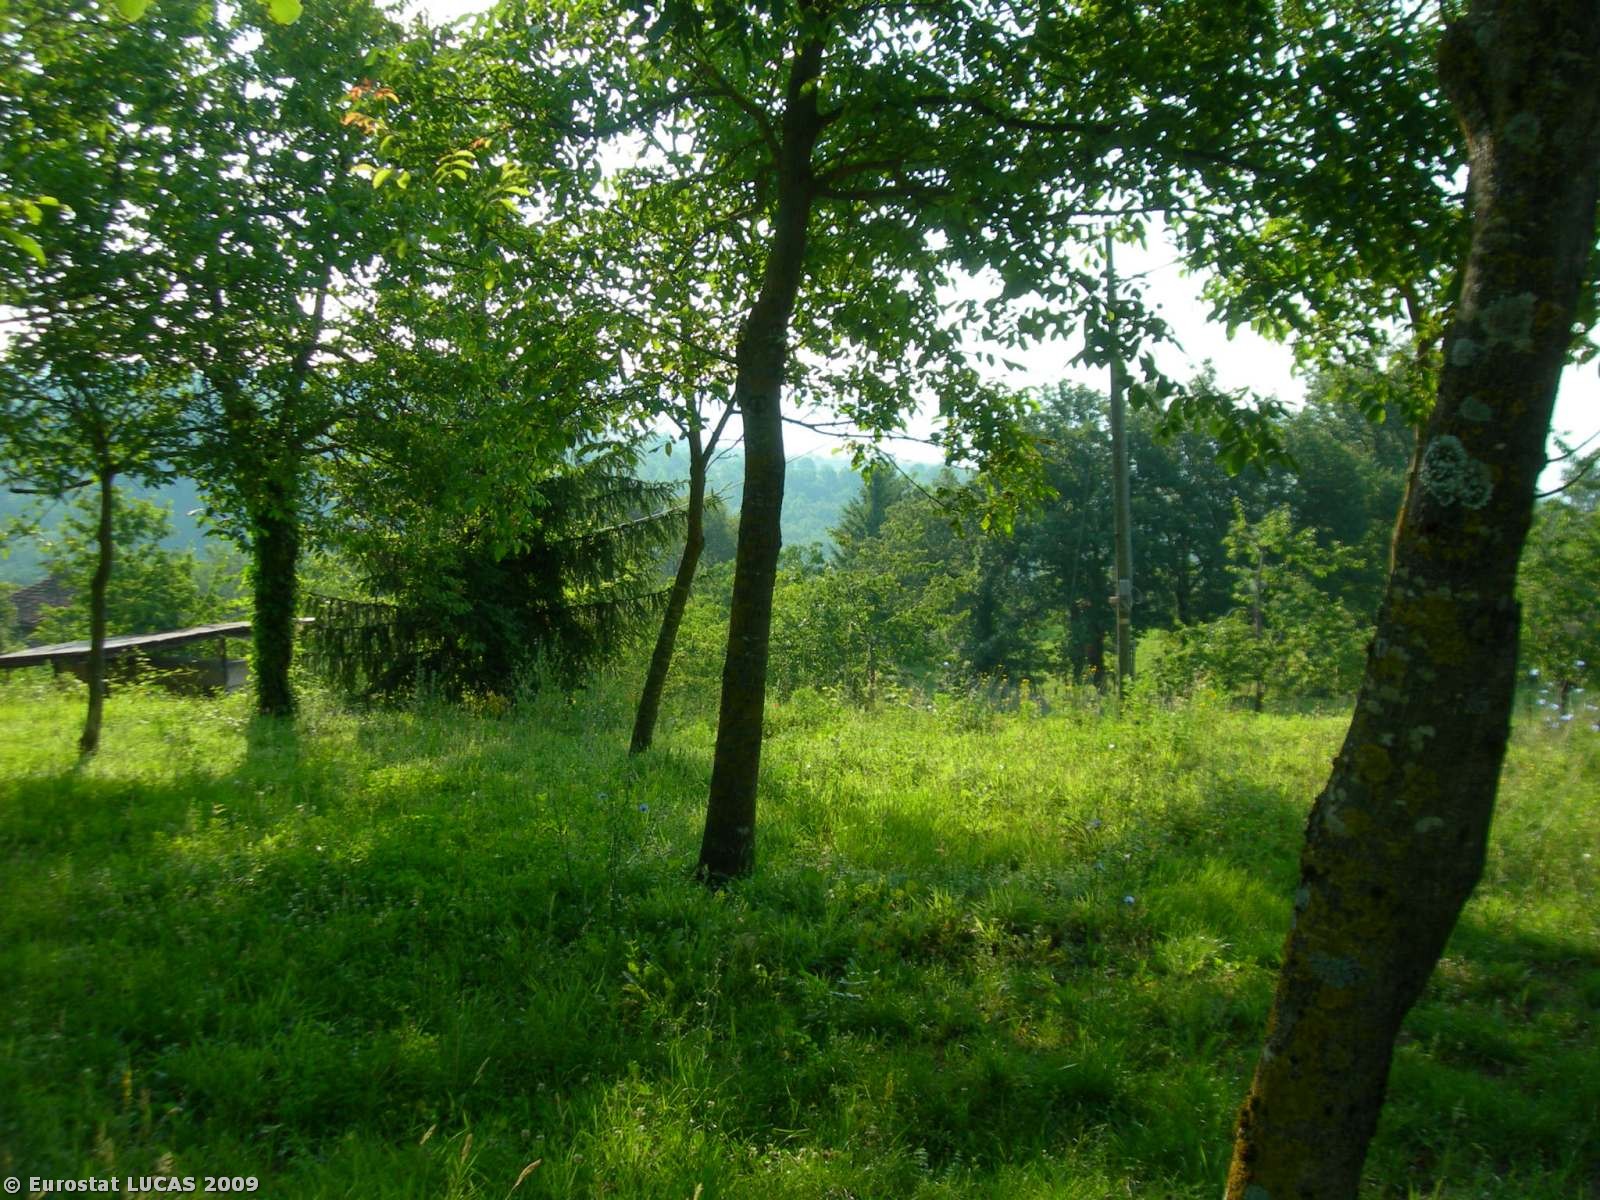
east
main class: Cropland
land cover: Nuts trees
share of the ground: 10 - 25 %
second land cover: Grassland with sparse tree/shrub cover
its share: > 75 %
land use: Agriculture (excluding fallow land and kitchen gardens)
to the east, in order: Nuts trees; Fences; Abandoned hedges; Artificial constructions in urban areas; Fences; Nuts trees; Grassland with sparse tree/shrub cover; Paved roads, cycling and walking lanes; Grassland without tree/shrub cover; Broadleaved woodland; Grassland without tree/shrub cover; Electric lines; Grassland without tree/shrub cover
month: July
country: IT
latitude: 43.7593
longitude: 11.6973
